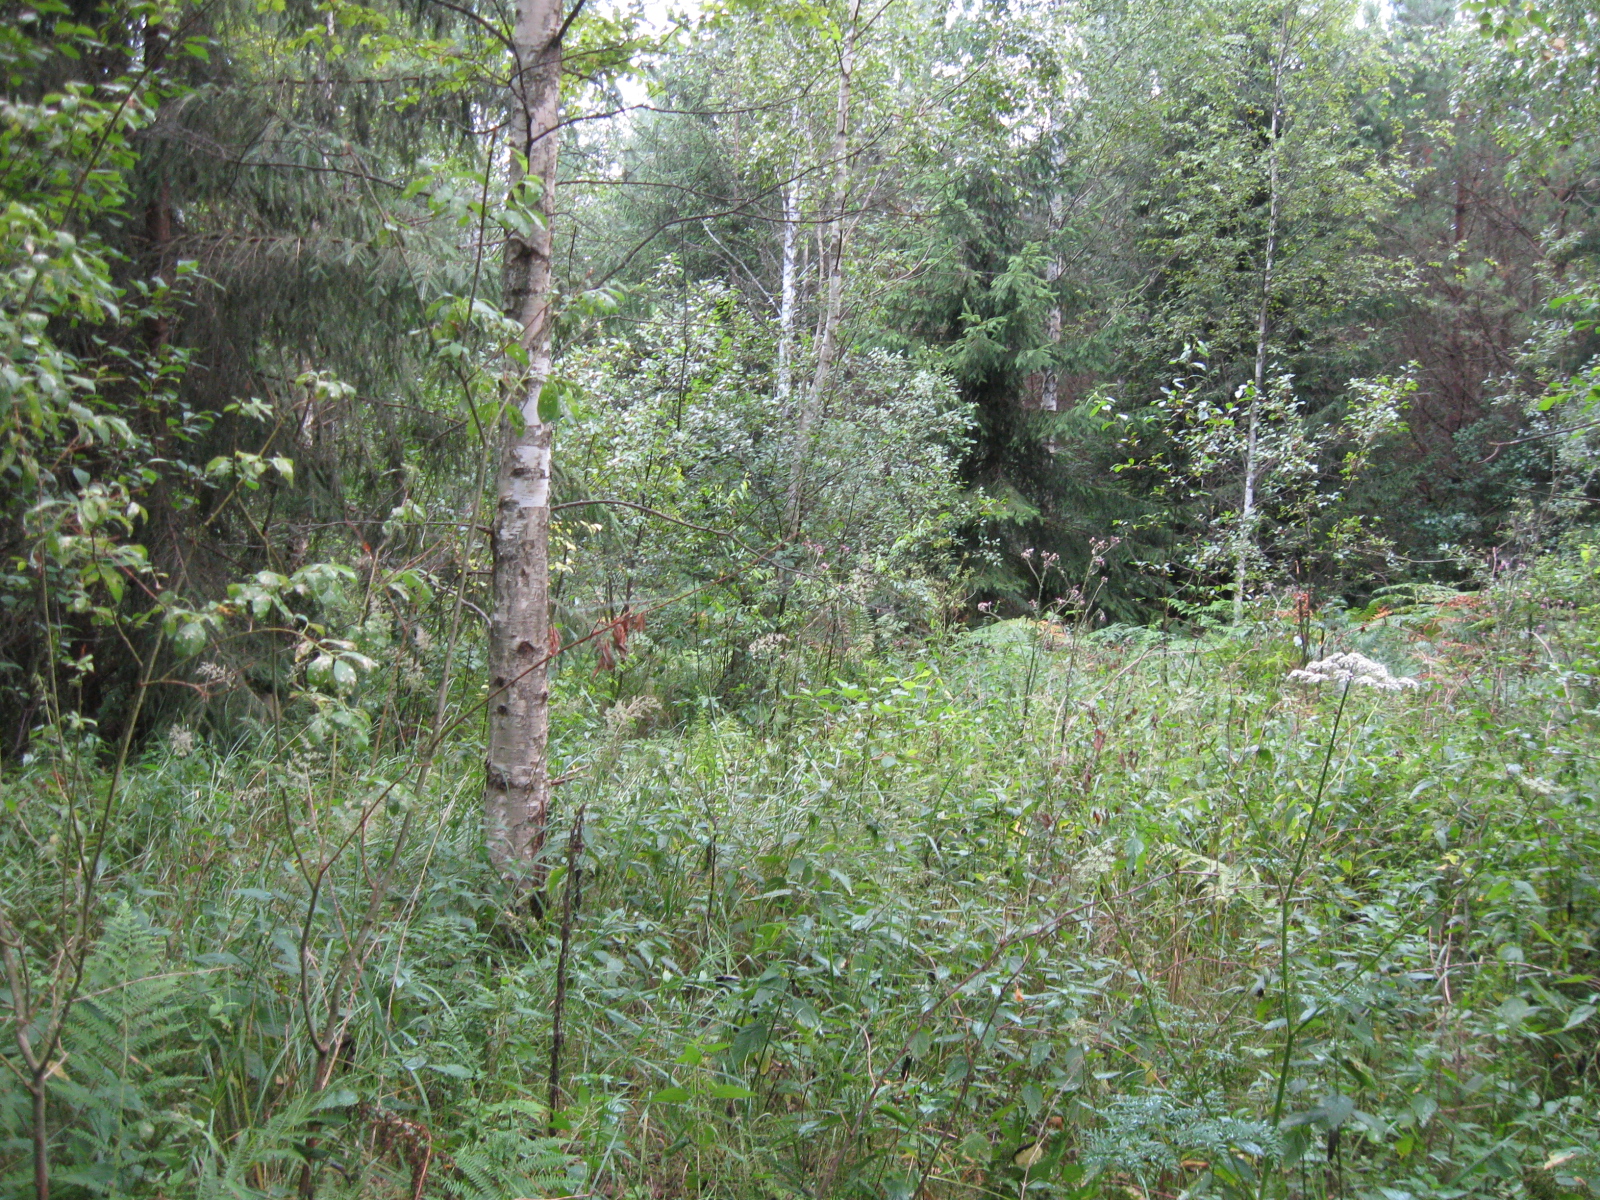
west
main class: Woodland
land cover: Broadleaved woodland
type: non-riverine alder, birch or aspen forest
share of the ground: > 75 %
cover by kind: broadleaved forest trees 70 %, herbaceous plants 20 %, coniferous forest trees 10 %
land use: Forestry
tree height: > 5 m
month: July
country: LT
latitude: 54.9315
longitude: 23.5820
